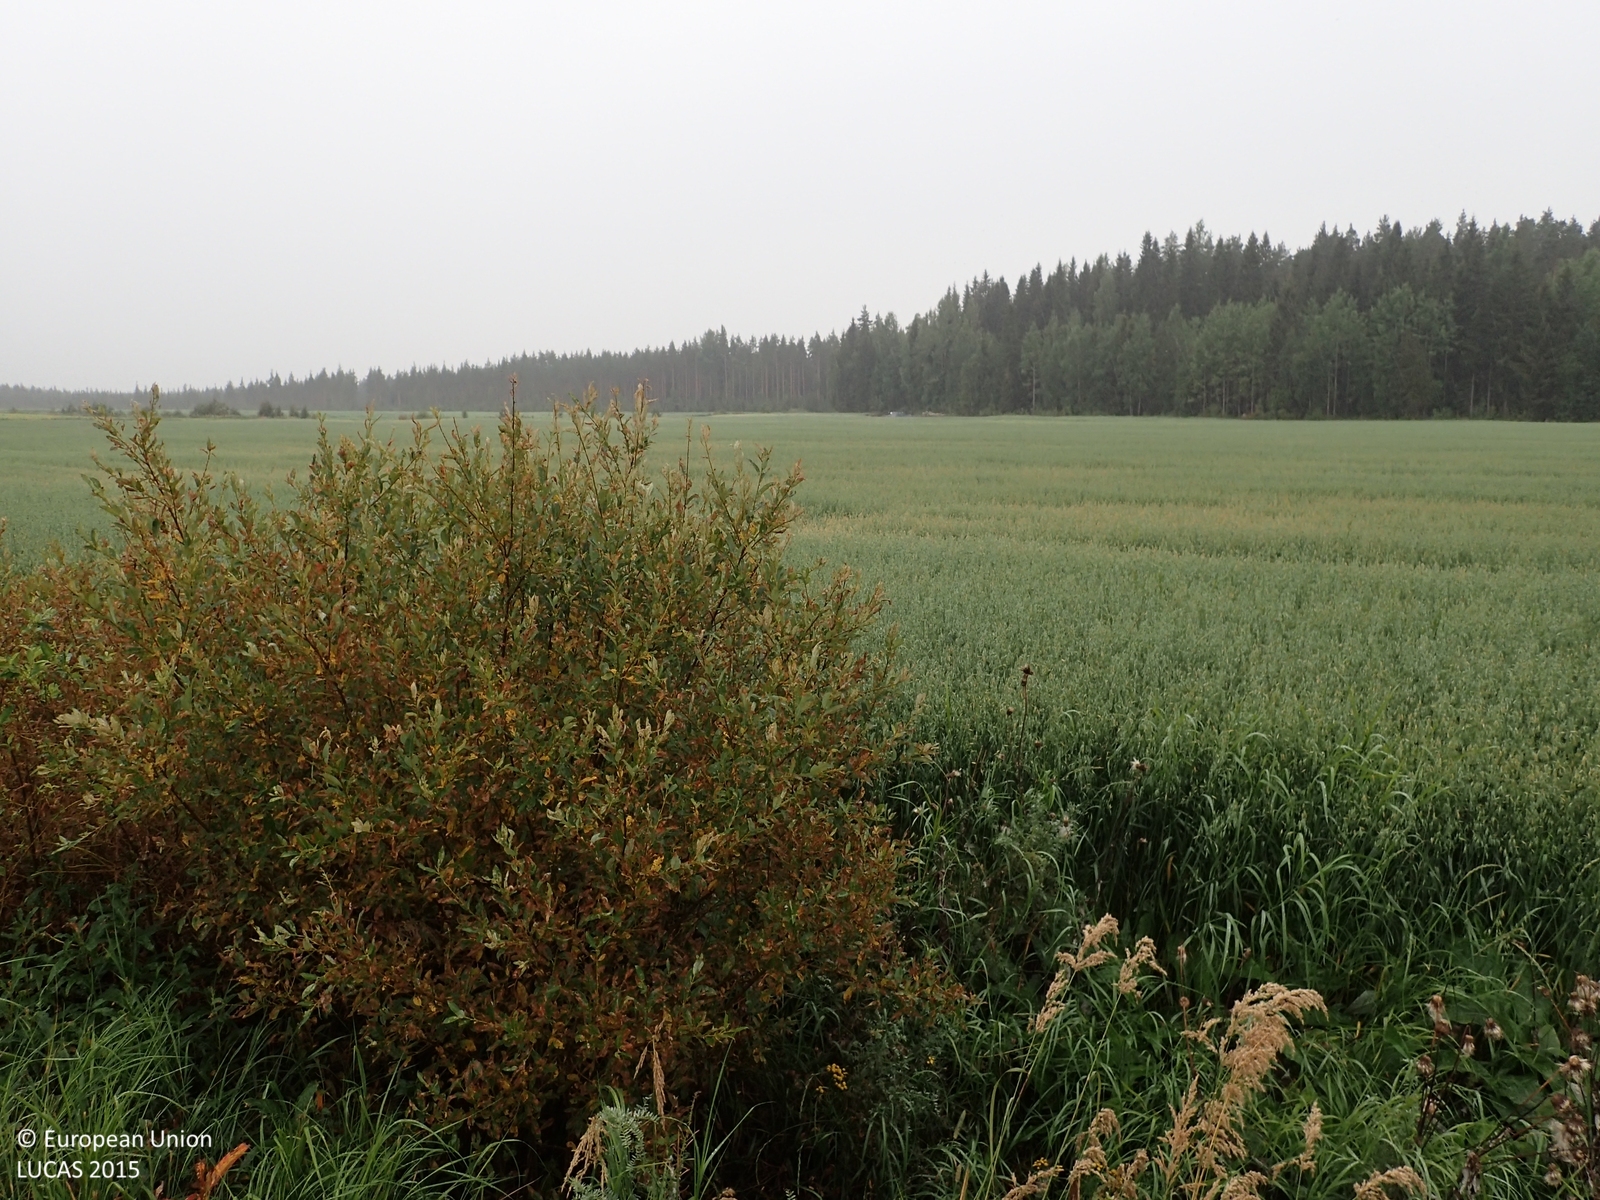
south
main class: Cropland
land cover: Oats
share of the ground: > 75 %
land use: Agriculture (excluding fallow land and kitchen gardens)
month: August
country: FI
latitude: 62.6671
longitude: 22.8065
